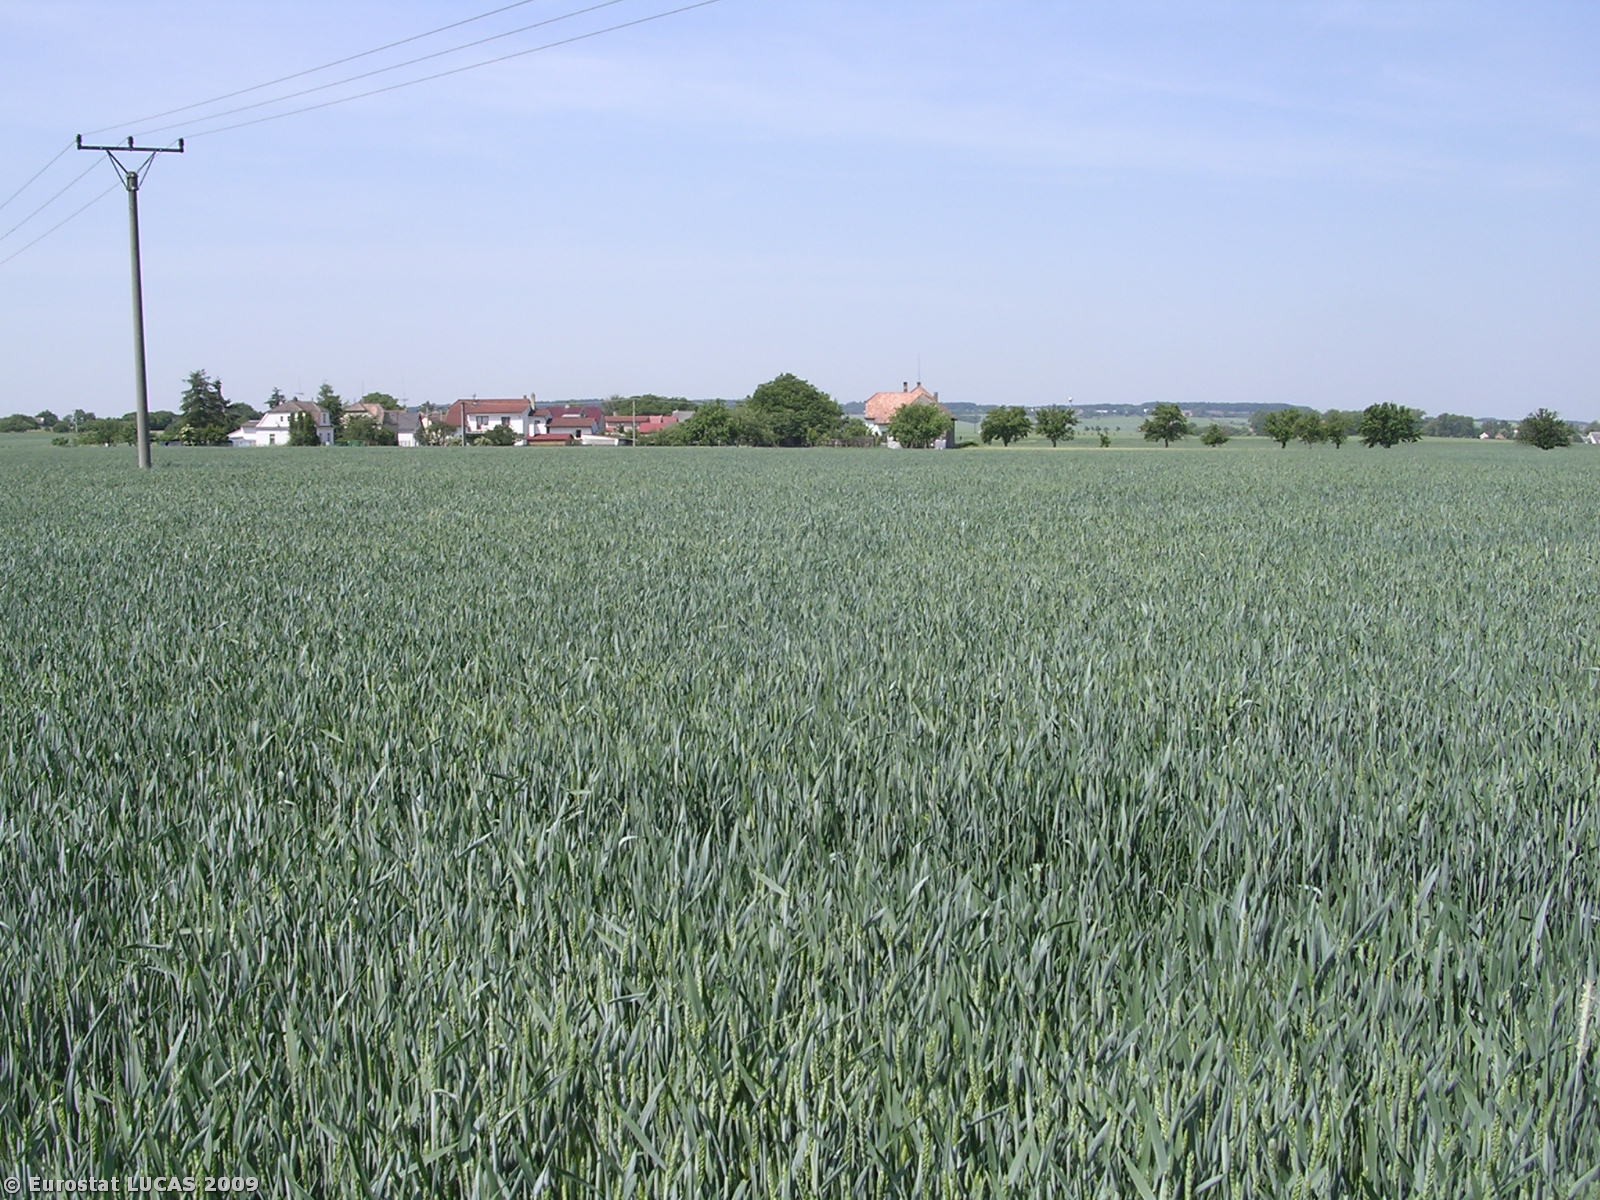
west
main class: Cropland
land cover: Common wheat
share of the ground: > 75 %
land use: Agriculture (excluding fallow land and kitchen gardens)
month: May
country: CZ
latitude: 50.3477
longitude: 14.9353
